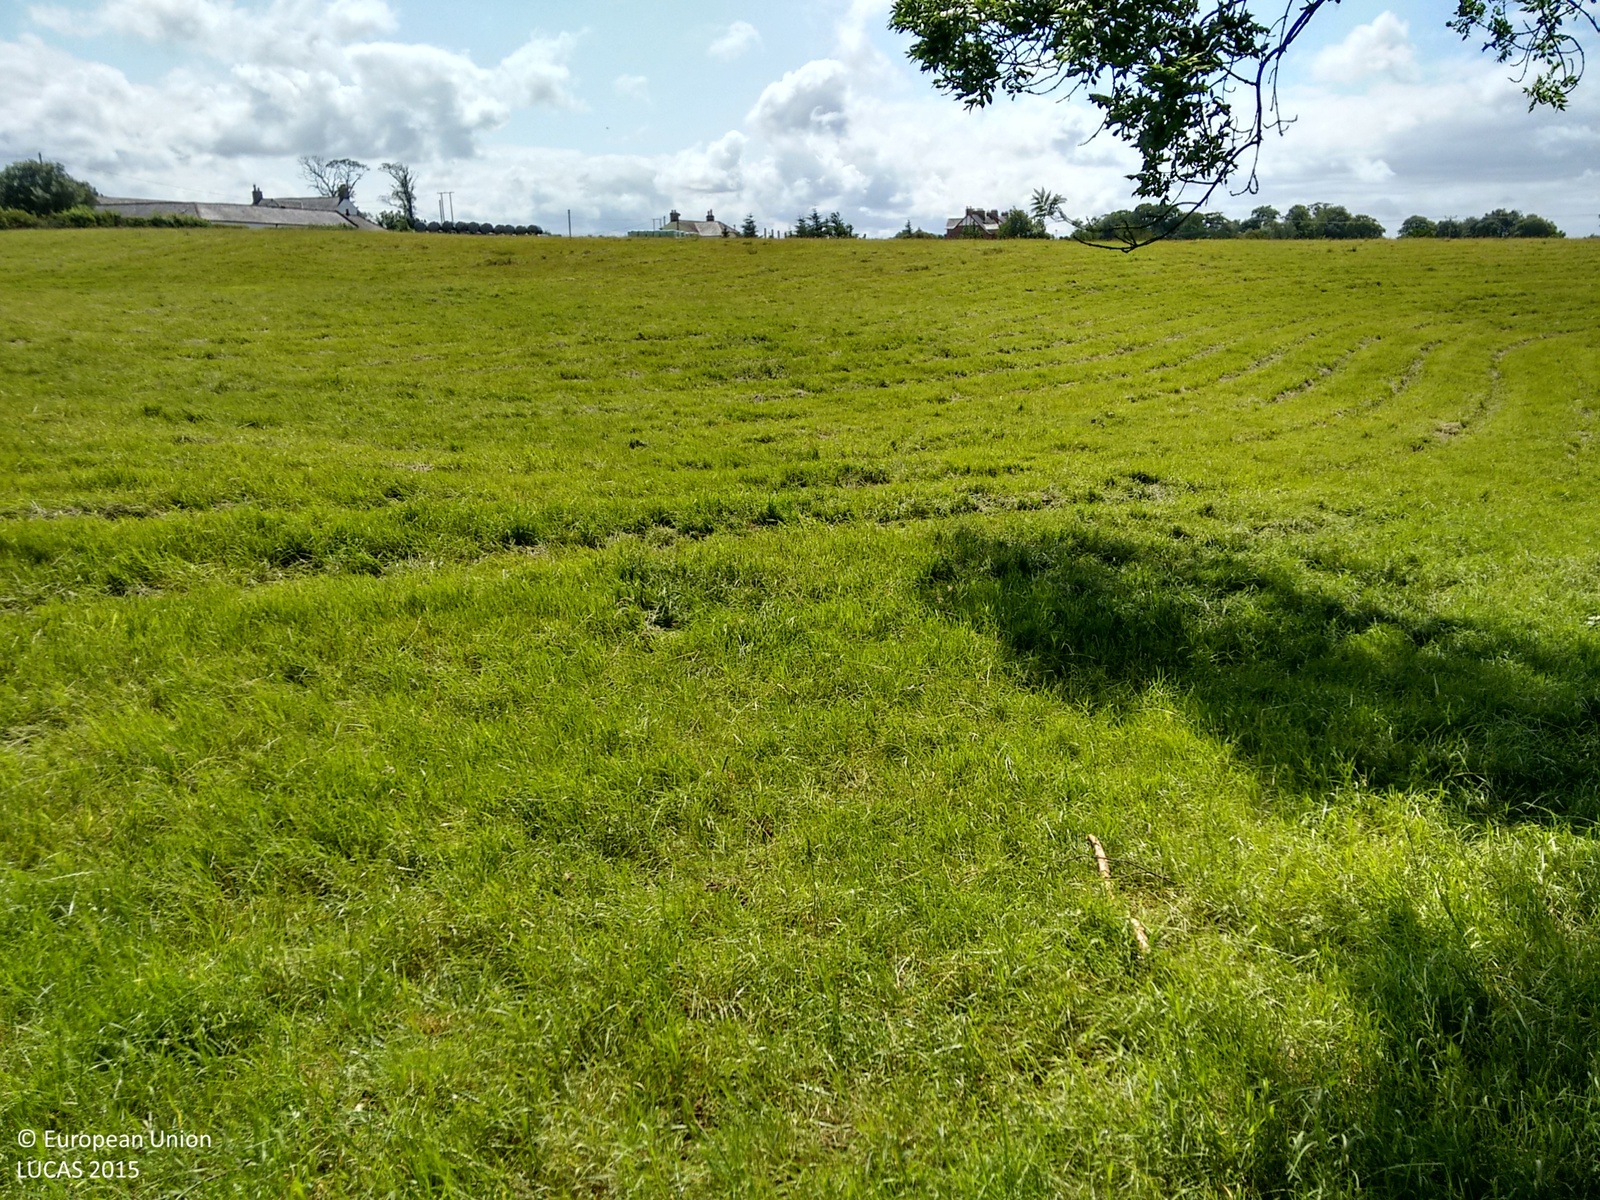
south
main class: Grassland
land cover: Grassland without tree/shrub cover
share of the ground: > 75 %
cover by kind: herbaceous plants 100 %
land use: Agriculture (excluding fallow land and kitchen gardens)
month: July
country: GB
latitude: 55.0034
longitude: -3.2556
